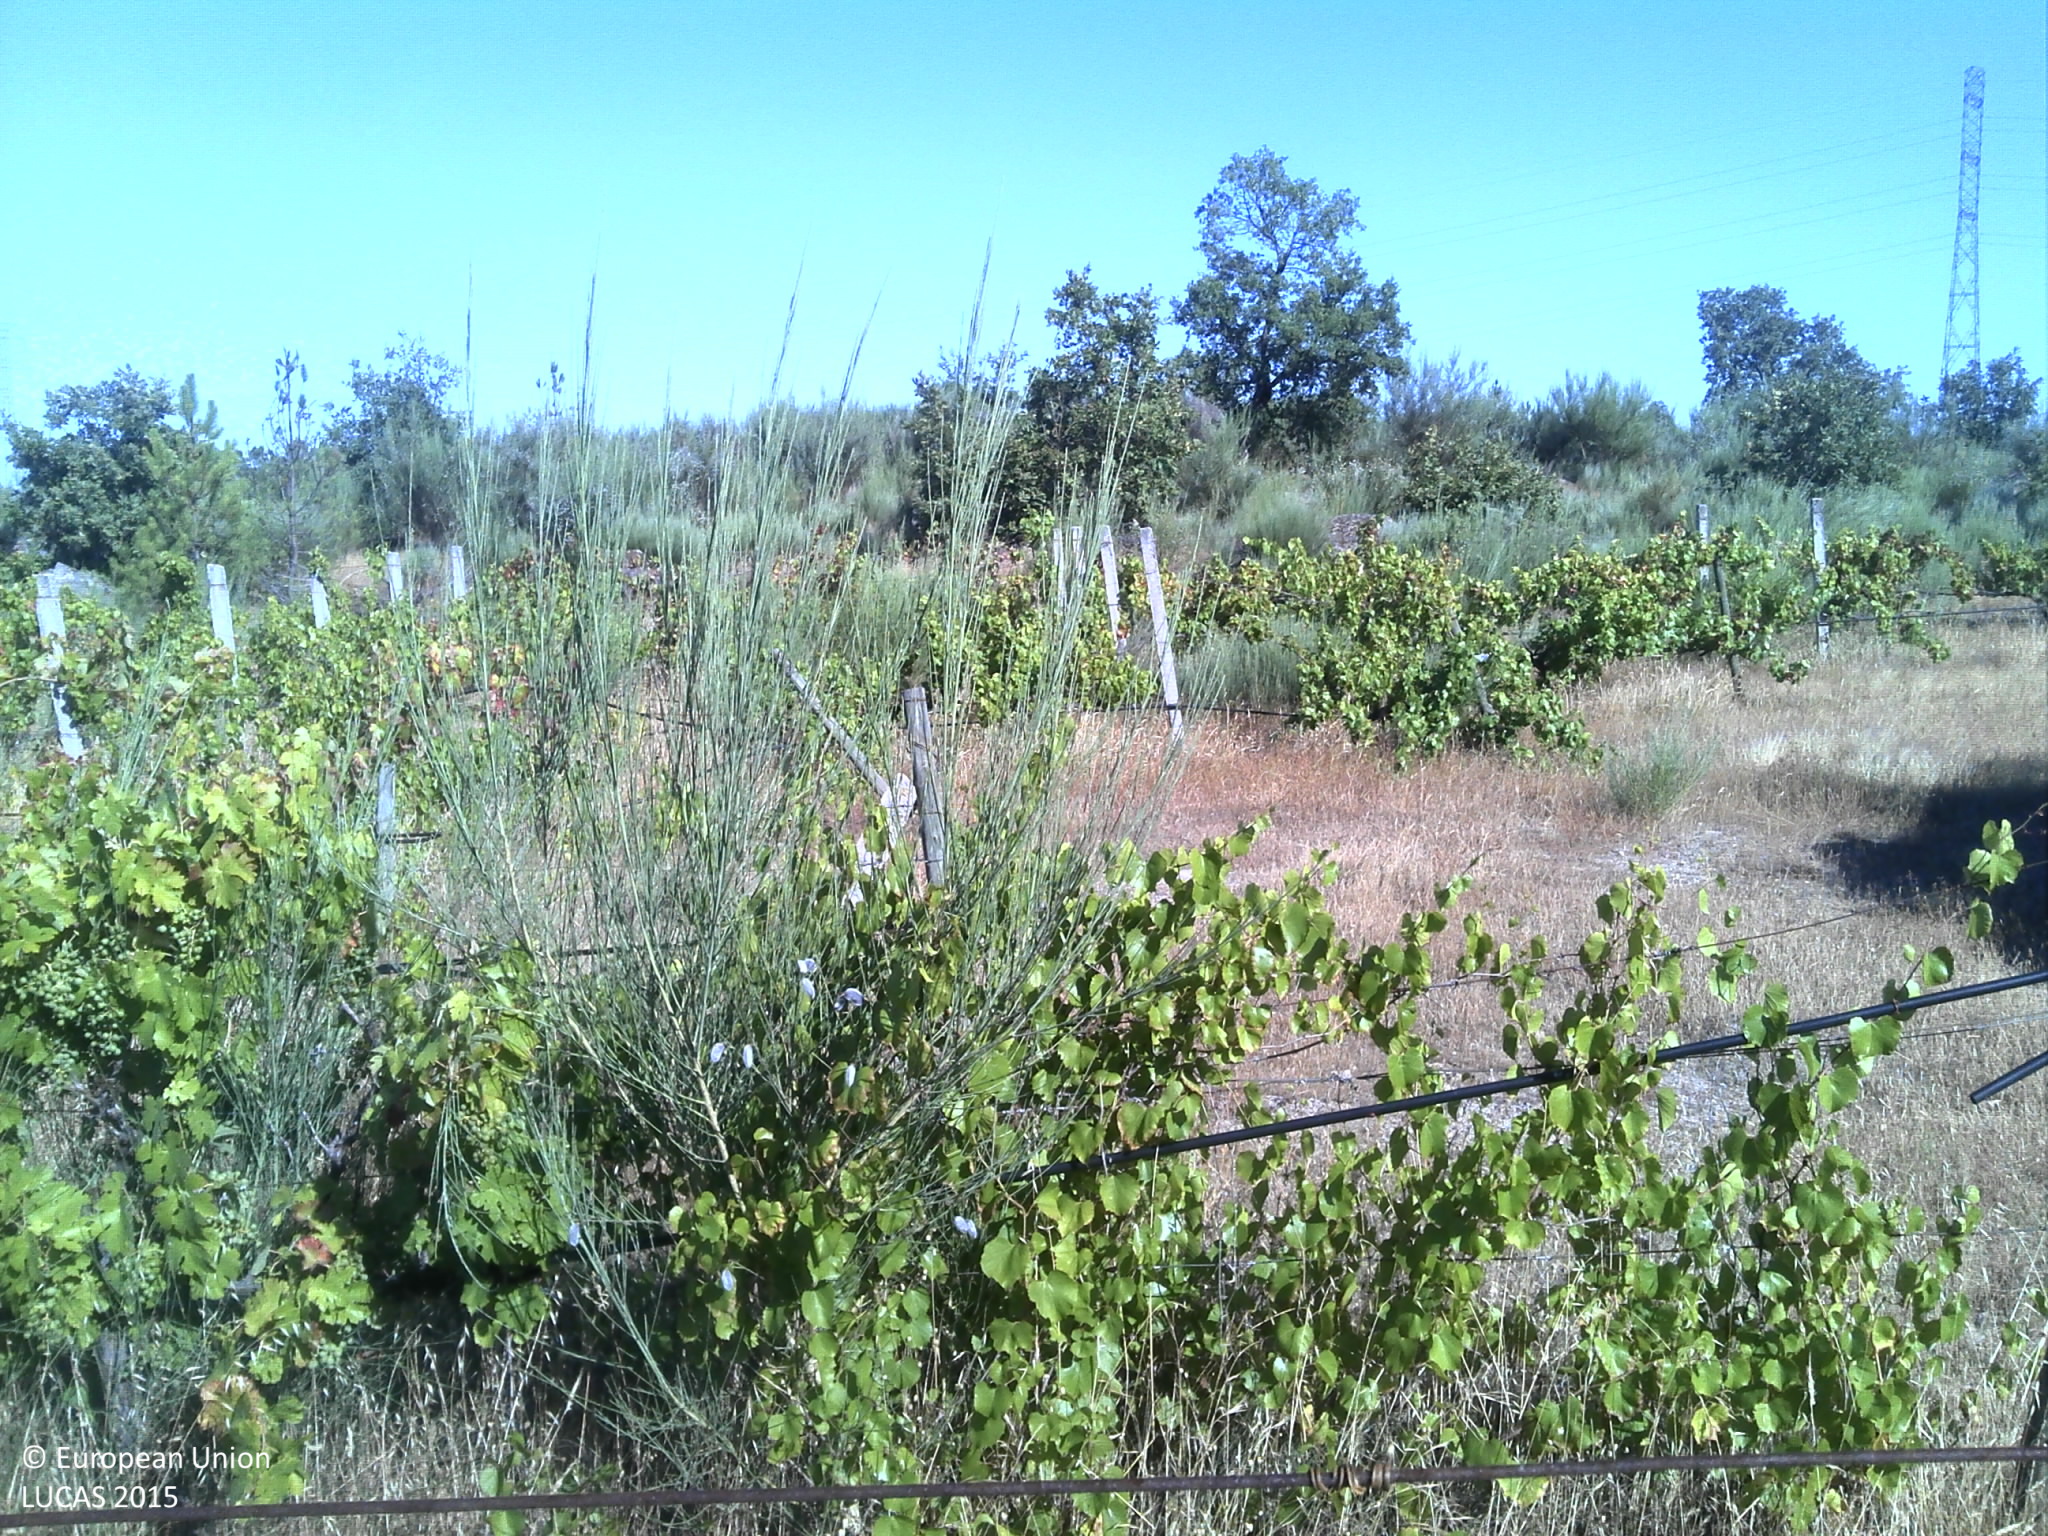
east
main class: Cropland
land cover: Vineyards
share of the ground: 25 - 50 %
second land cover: Spontaneously vegetated surfaces
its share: > 75 %
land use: Agriculture (excluding fallow land and kitchen gardens)
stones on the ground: 10 - 25 %
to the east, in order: Vineyards; Spontaneously vegetated surfaces; Shrubland without tree cover; Rock outcrops; Shrubland without tree cover; Grassland without tree/shrub cover; Grass margins; Grassland without tree/shrub cover; Vineyards
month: June
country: PT
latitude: 40.0398
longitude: -7.4354
